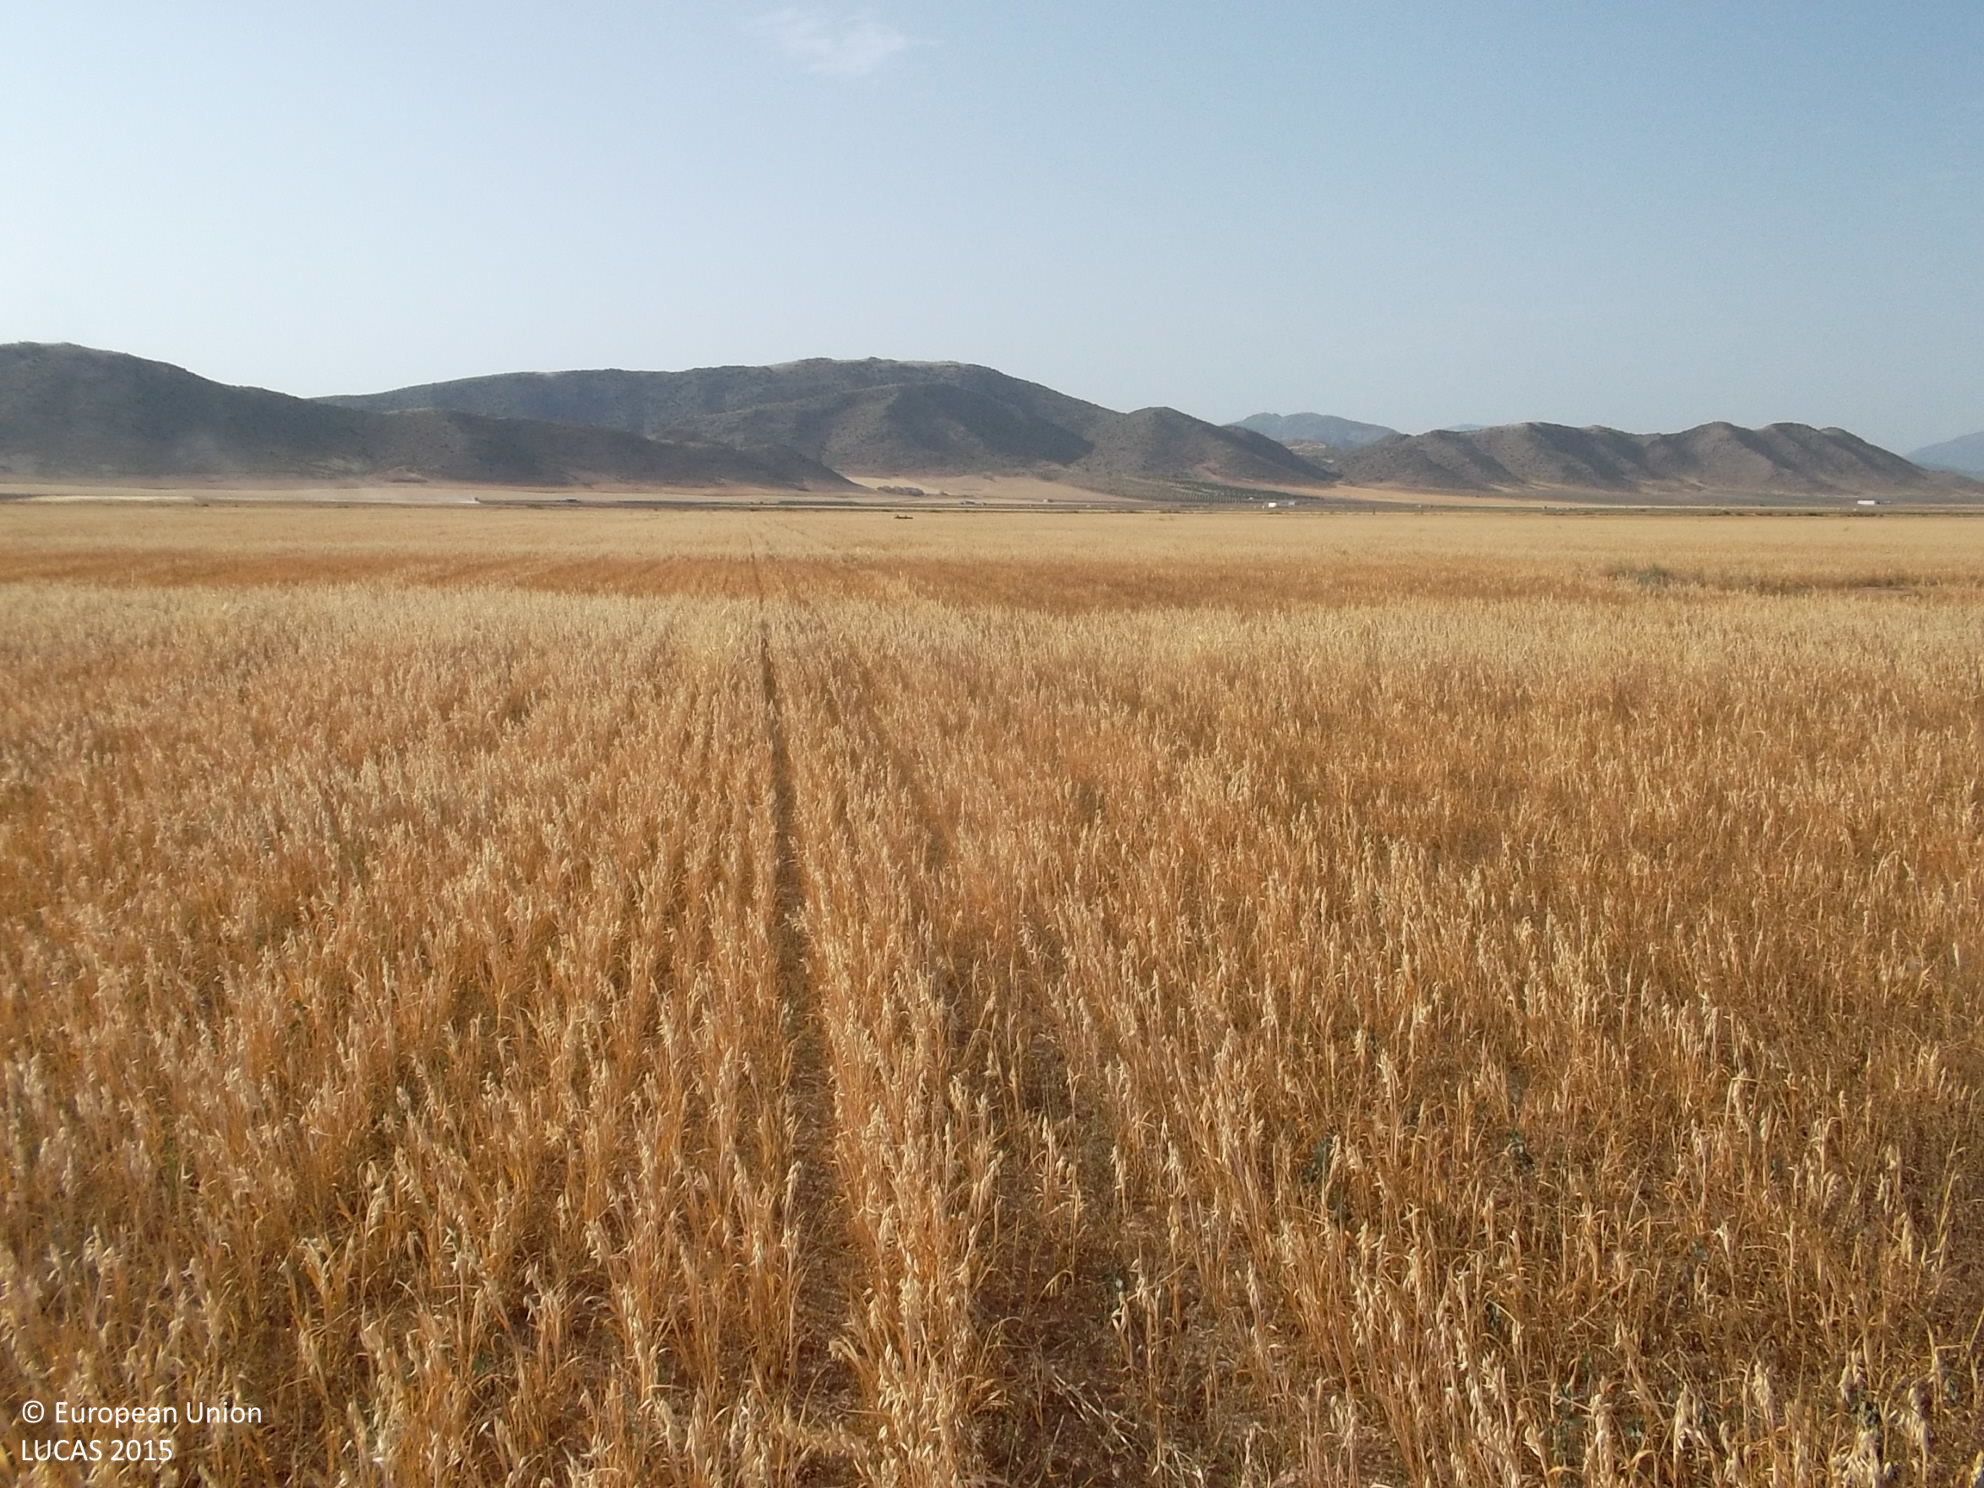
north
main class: Cropland
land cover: Oats
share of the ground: > 75 %
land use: Agriculture (excluding fallow land and kitchen gardens)
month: July
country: ES
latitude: 37.8918
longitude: -2.3502
